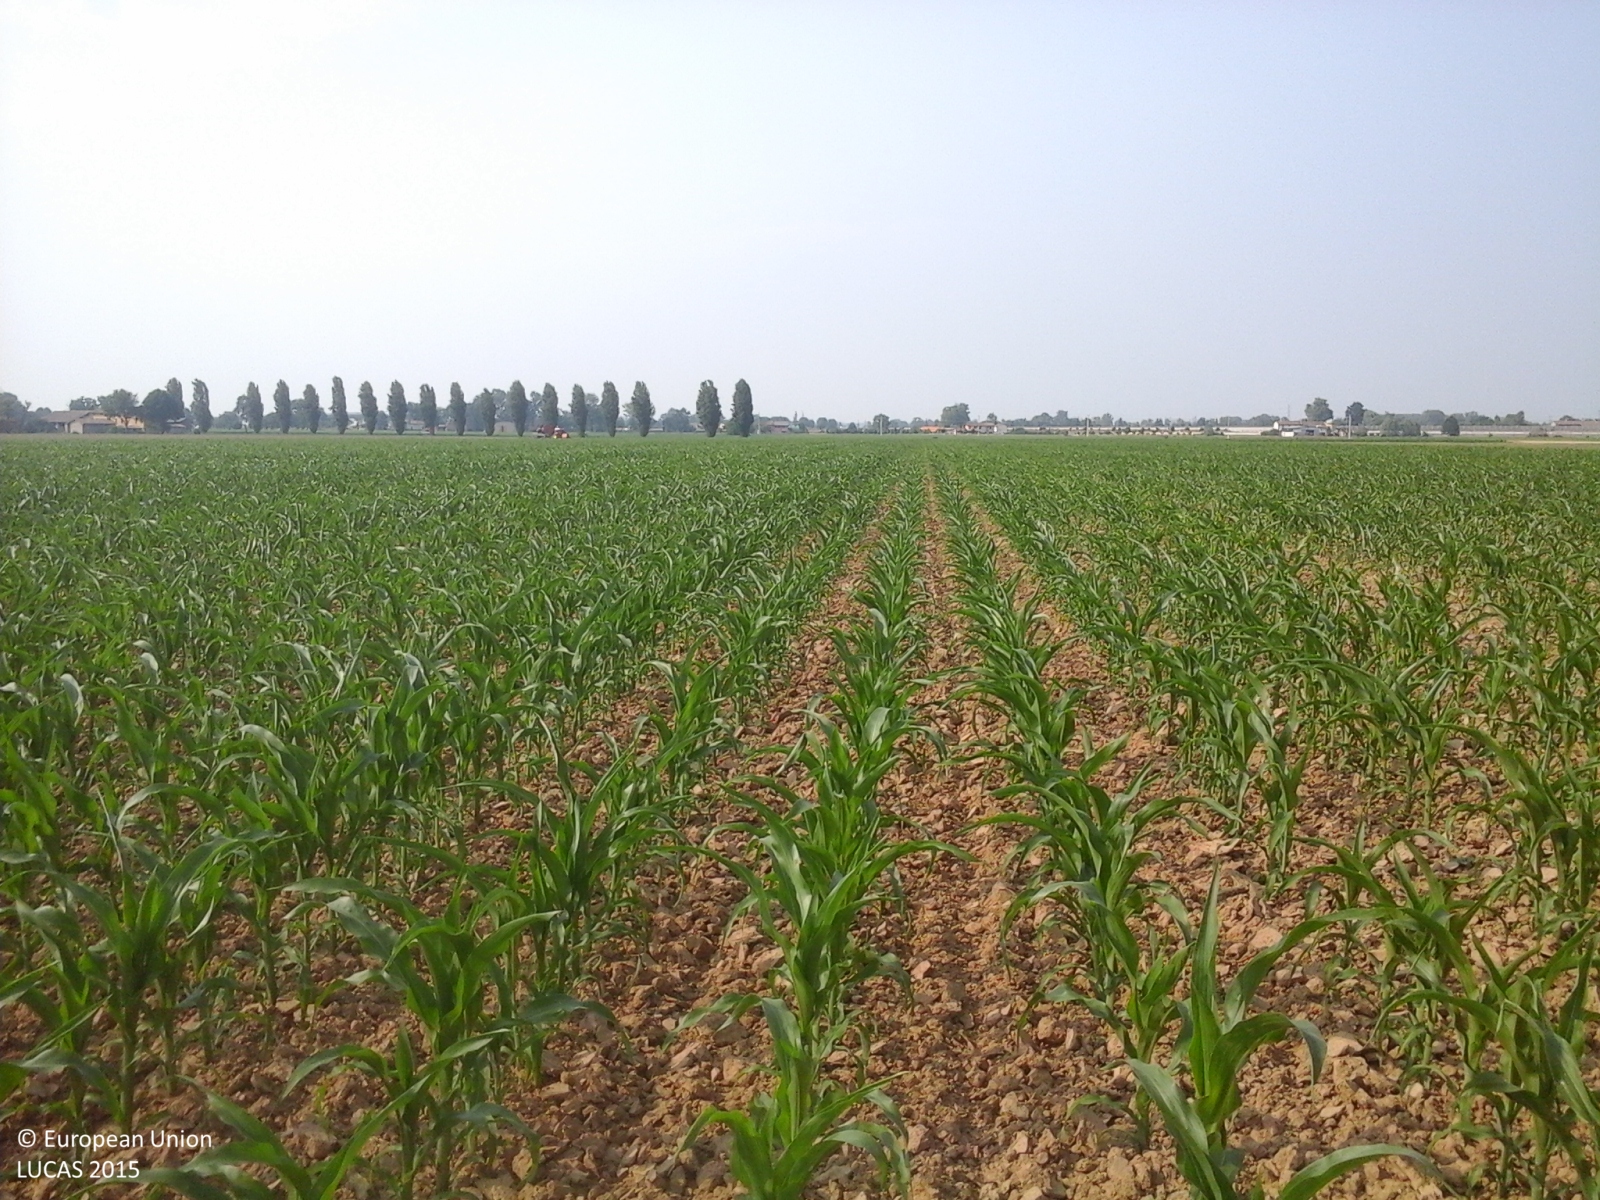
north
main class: Cropland
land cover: Maize
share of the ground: 25 - 50 %
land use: Agriculture (excluding fallow land and kitchen gardens)
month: June
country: IT
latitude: 44.9276
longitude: 9.9621
